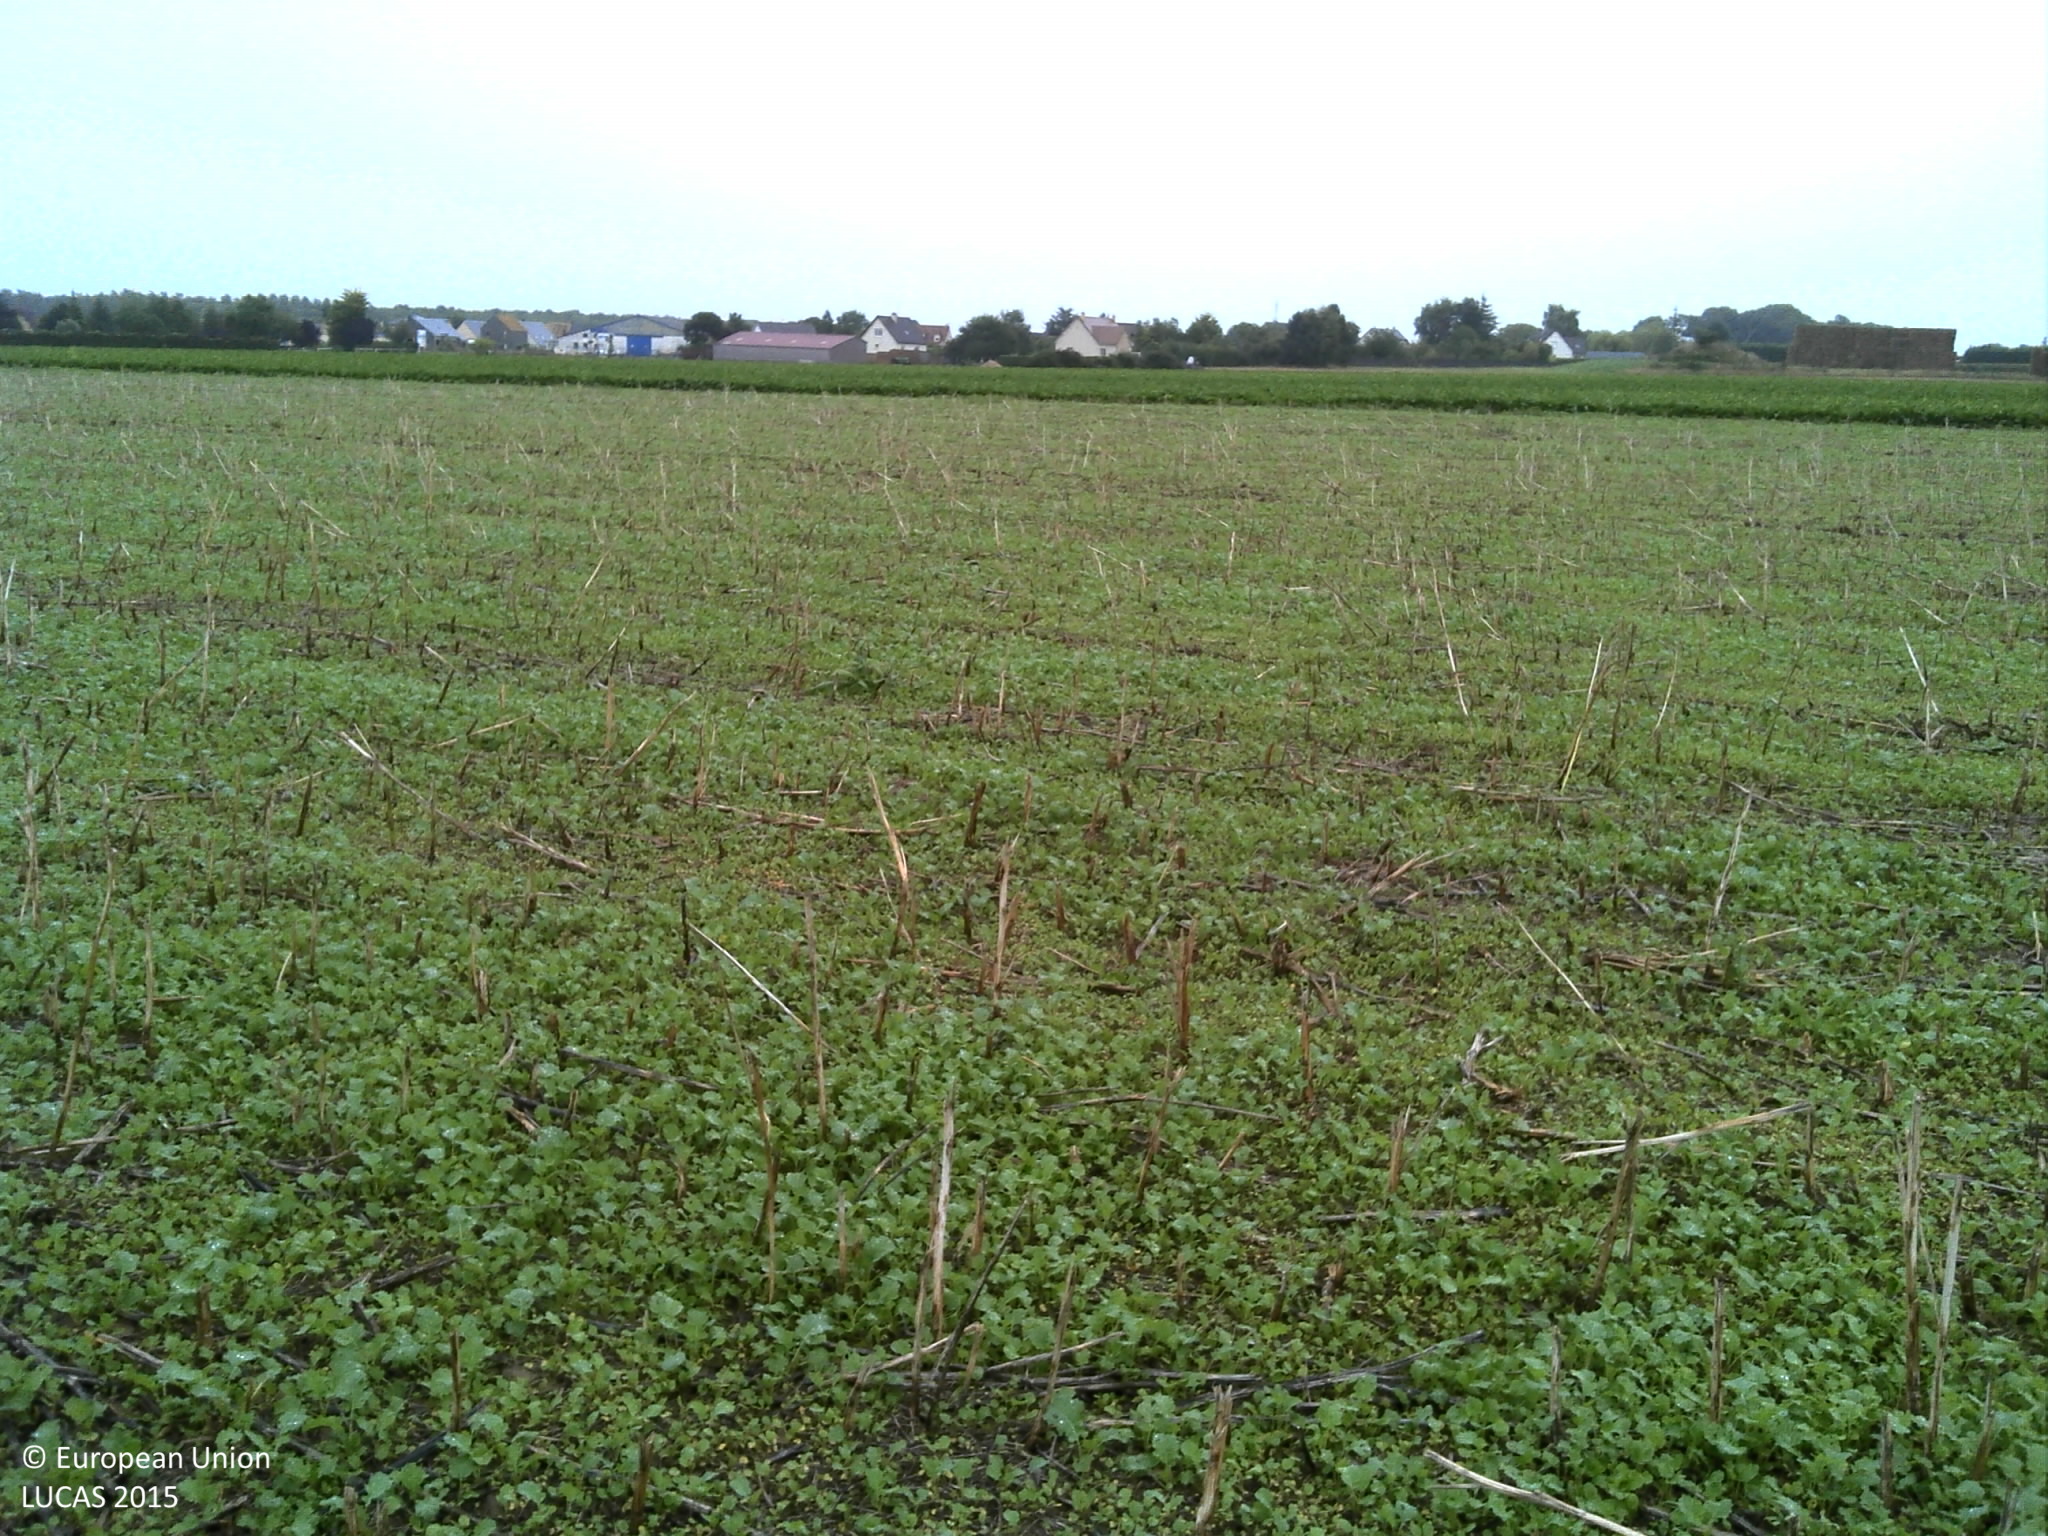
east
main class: Cropland
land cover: Rape and turnip rape
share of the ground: 25 - 50 %
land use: Agriculture (excluding fallow land and kitchen gardens)
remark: Harvested field
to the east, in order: Rape and turnip rape; Sugar beet; Common wheat; Abandoned hedges; Common wheat; Other bare soil
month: August
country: FR
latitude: 49.2633
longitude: -0.2993
